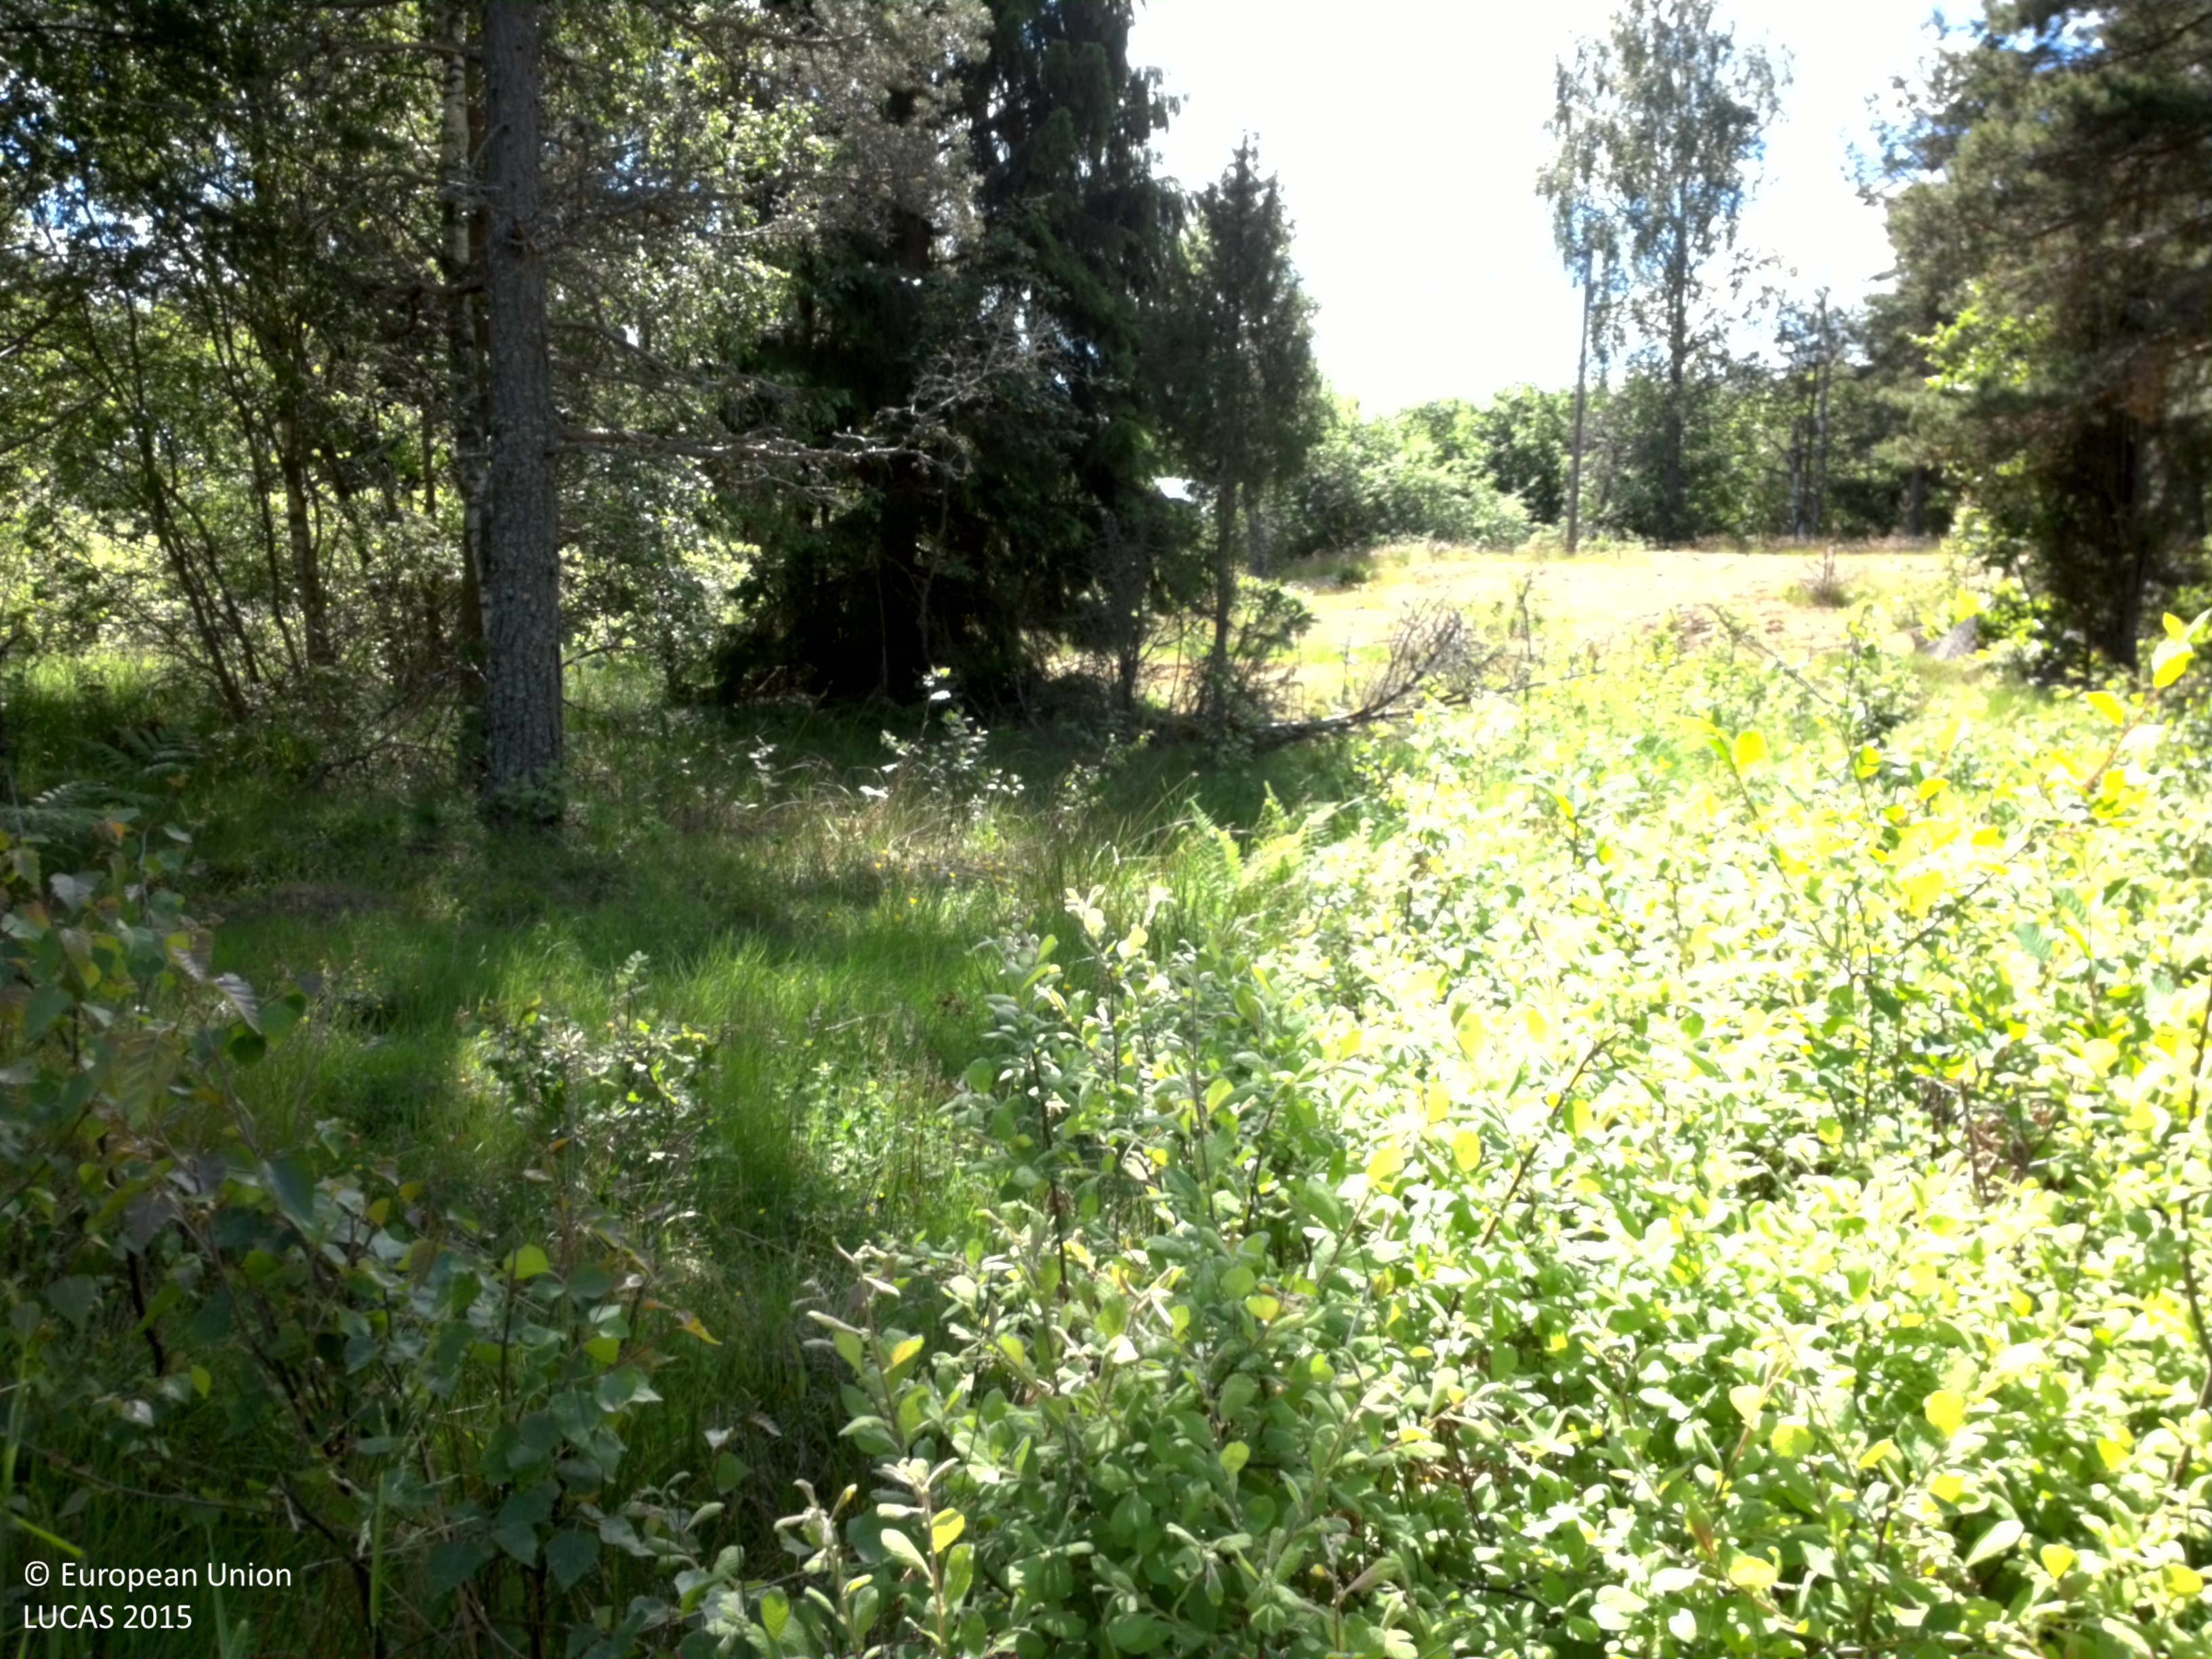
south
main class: Woodland
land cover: Other mixed woodland
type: boreal forest
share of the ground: 25 - 50 %
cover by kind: herbaceous plants 55 %, broadleaved forest trees 20 %, coniferous forest trees 15 %, shrubs 10 %
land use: Forestry
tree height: < 5 m
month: June
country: SE
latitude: 58.4273
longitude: 16.4175
